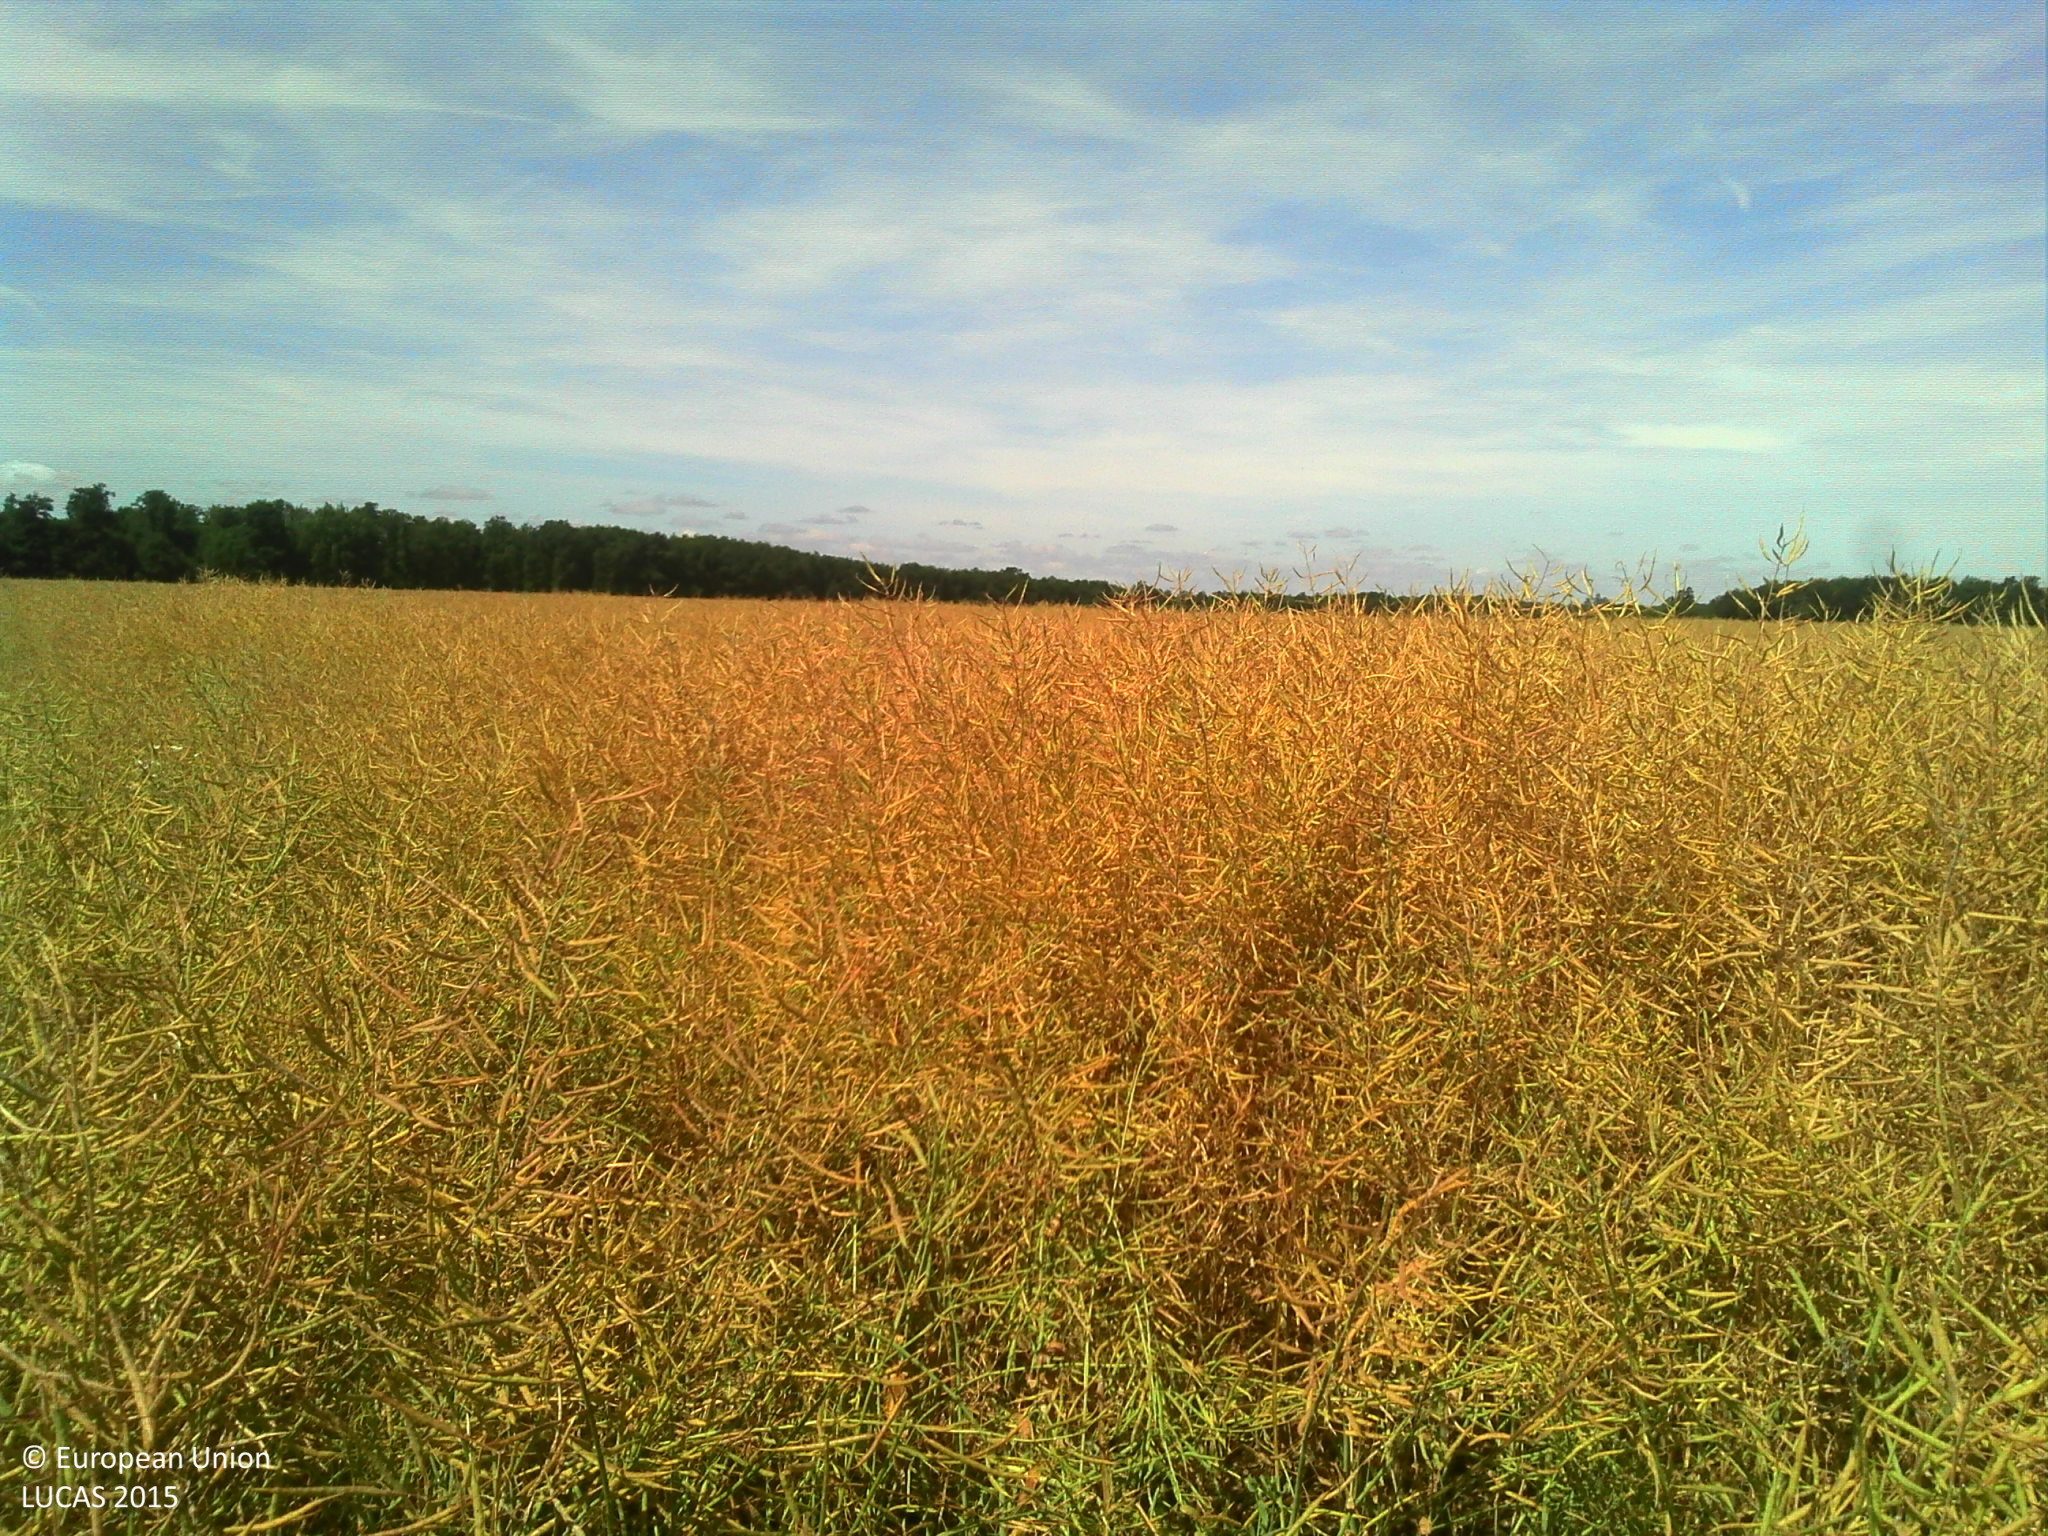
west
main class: Cropland
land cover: Rape and turnip rape
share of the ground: > 75 %
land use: Agriculture (excluding fallow land and kitchen gardens)
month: June
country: FR
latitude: 48.6313
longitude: 1.2017
